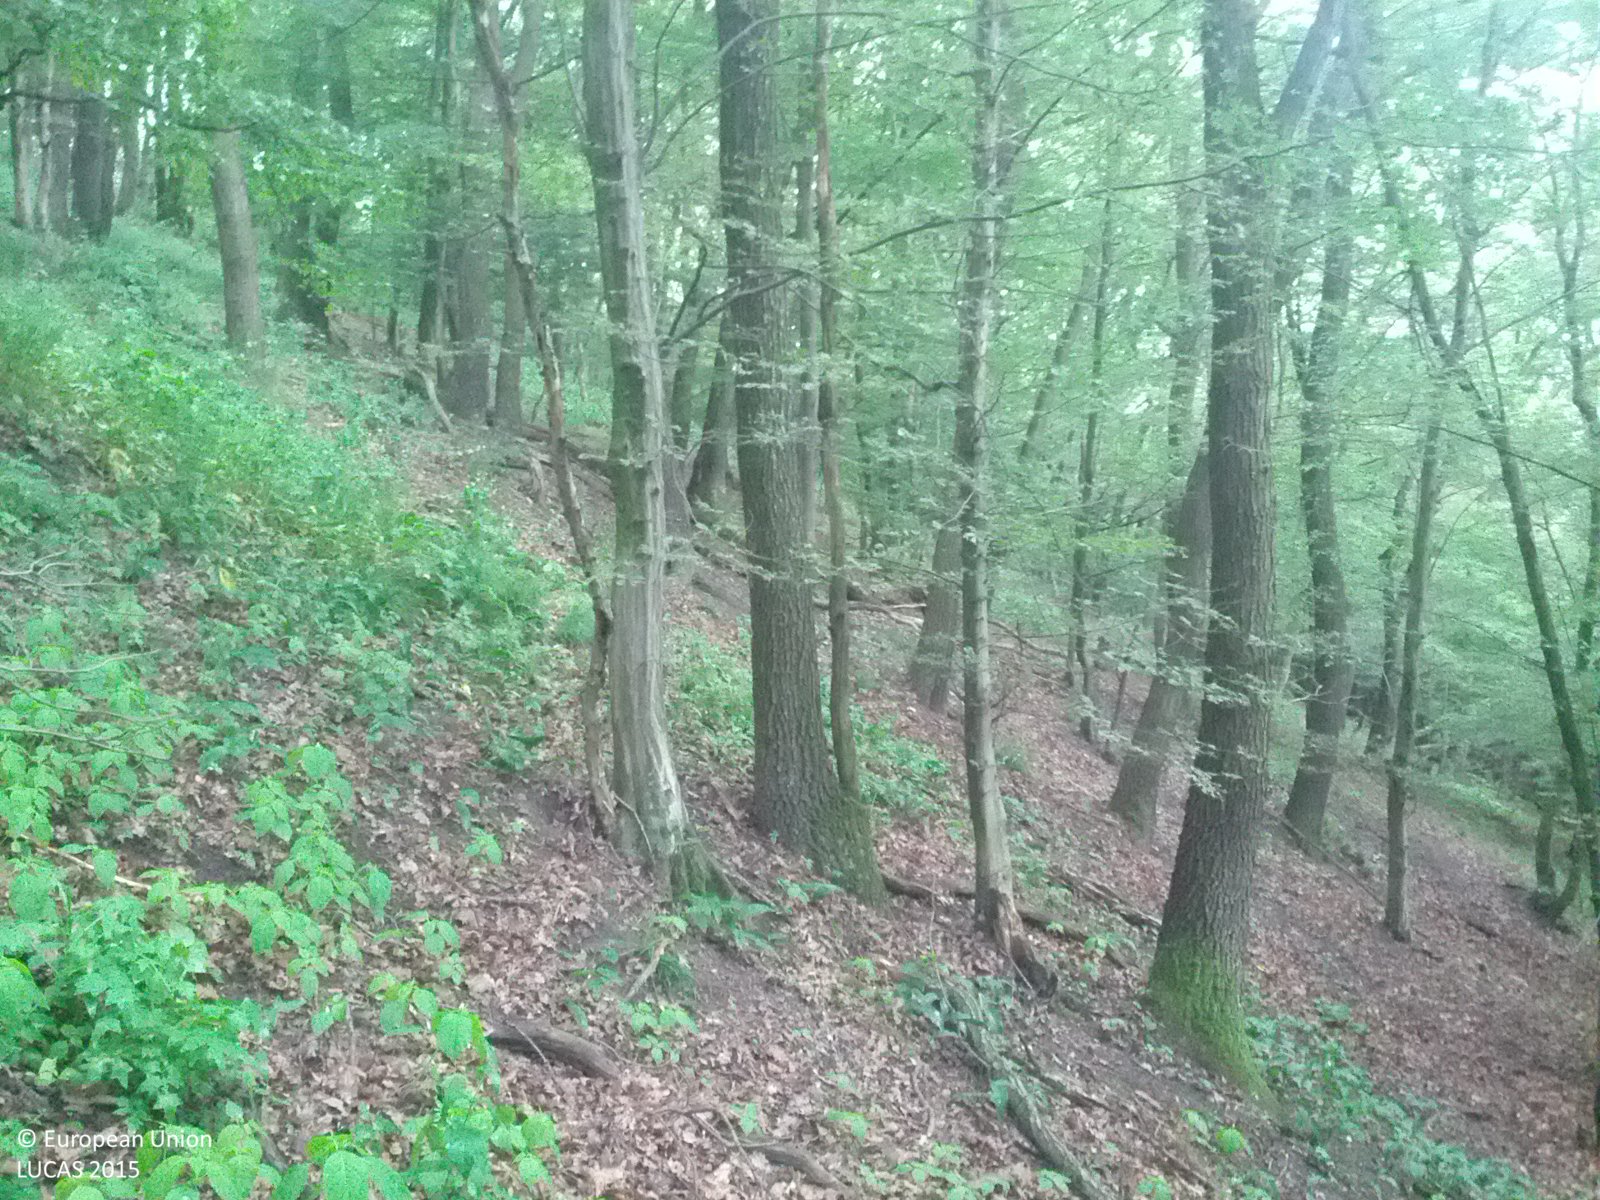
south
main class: Woodland
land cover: Broadleaved woodland
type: beech forest
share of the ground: > 75 %
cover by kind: broadleaved forest trees 90 %, herbaceous plants 10 %
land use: Forestry
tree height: > 5 m
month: May
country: AT
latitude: 48.2872
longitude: 16.1365
